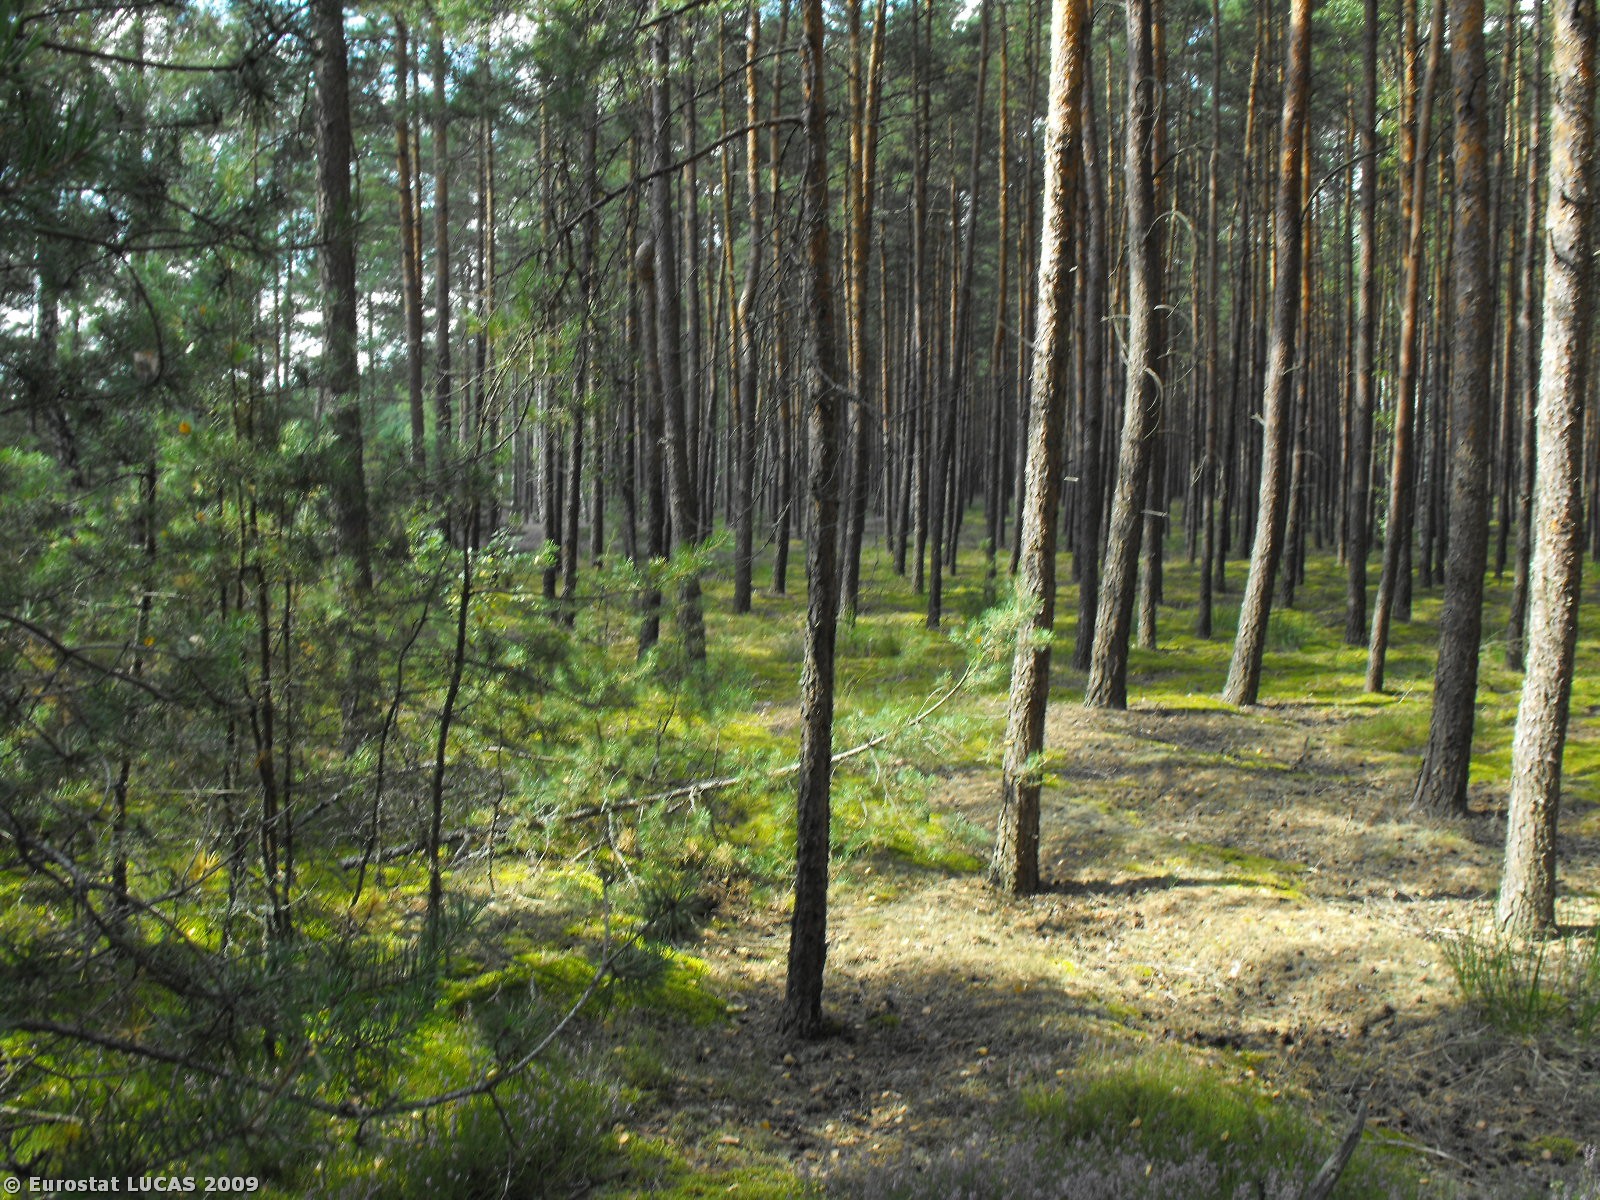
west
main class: Woodland
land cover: Coniferous woodland
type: hemiboreal forest and nemoral coniferous forest and mixed broadleaved-coniferous forest
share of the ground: 50 - 75 %
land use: Forestry
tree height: > 5 m
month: September
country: PL
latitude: 52.7820
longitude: 16.3969
